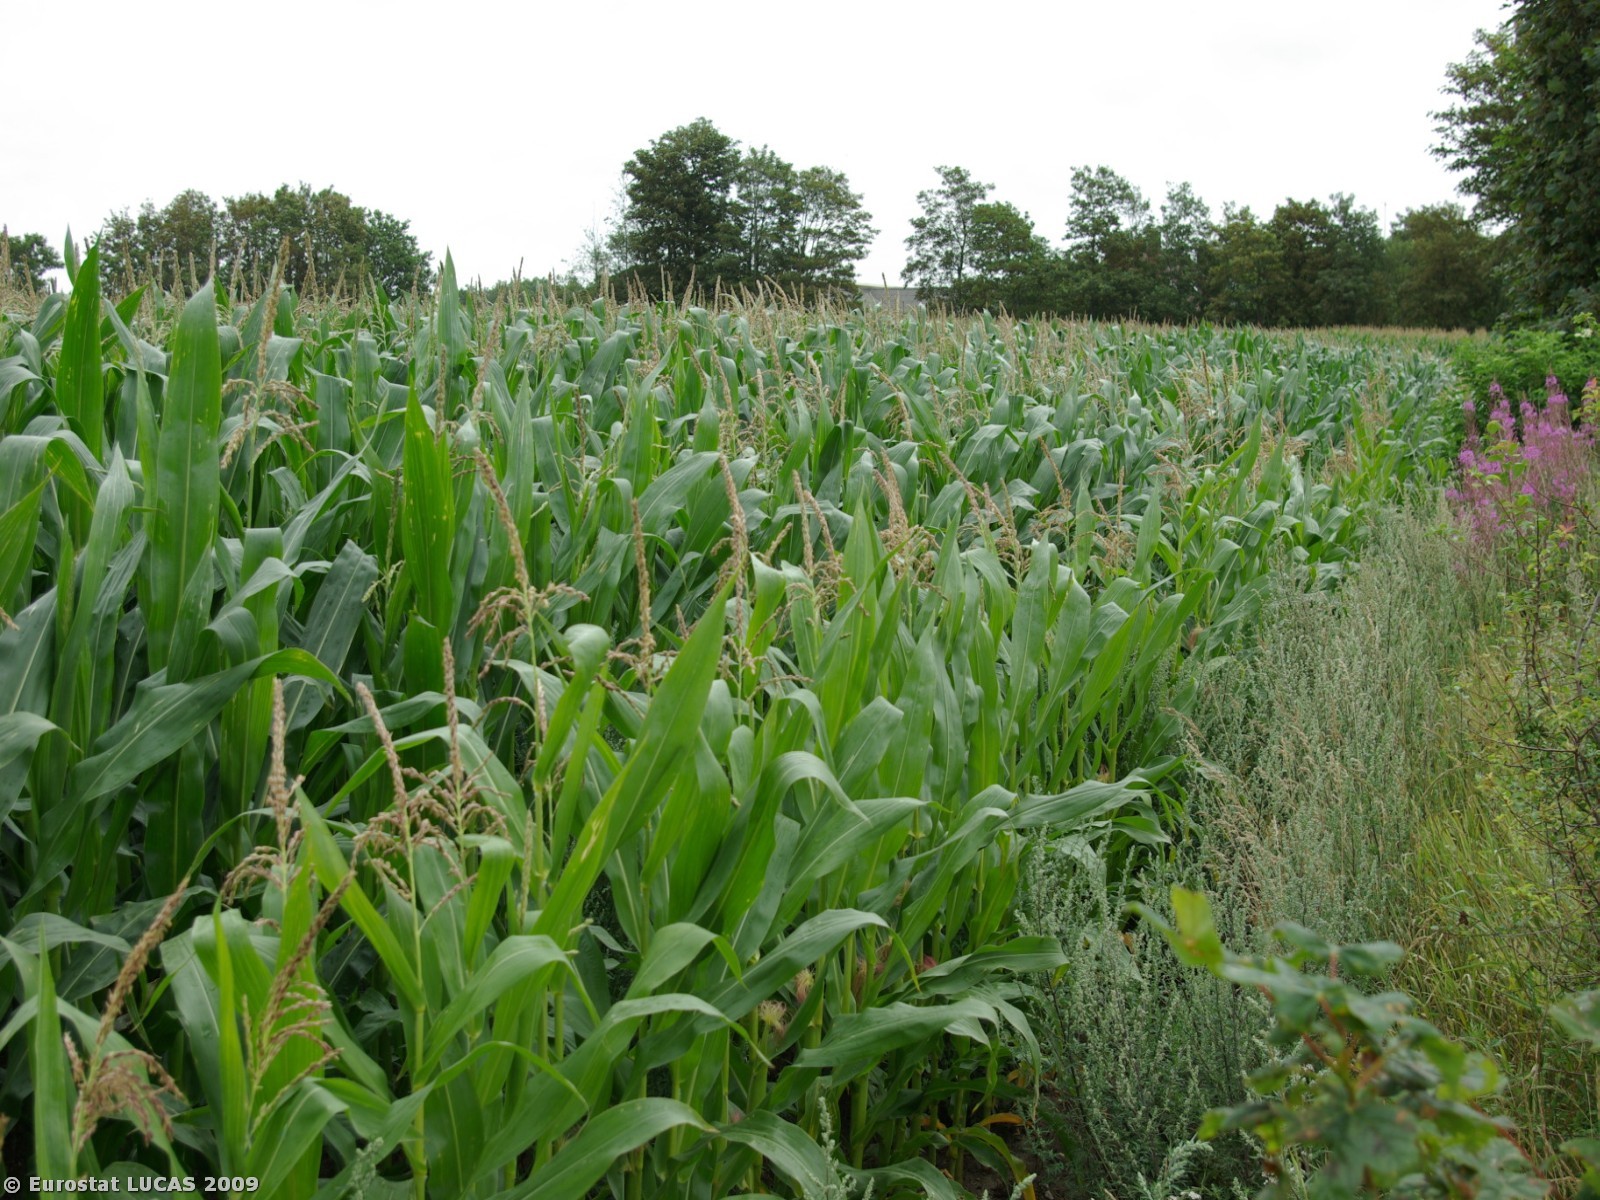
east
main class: Cropland
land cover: Maize
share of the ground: > 75 %
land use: Agriculture (excluding fallow land and kitchen gardens)
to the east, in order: Maize; Broadleaved woodland; Grass margins; Paved roads, cycling and walking lanes; Grassland without tree/shrub cover; Managed hedges; Broadleaved woodland; Artificial constructions in urban areas; Bare land; Broadleaved woodland; Spontaneously vegetated surfaces; Maize
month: July
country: DK
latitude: 55.1223
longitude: 8.8876
